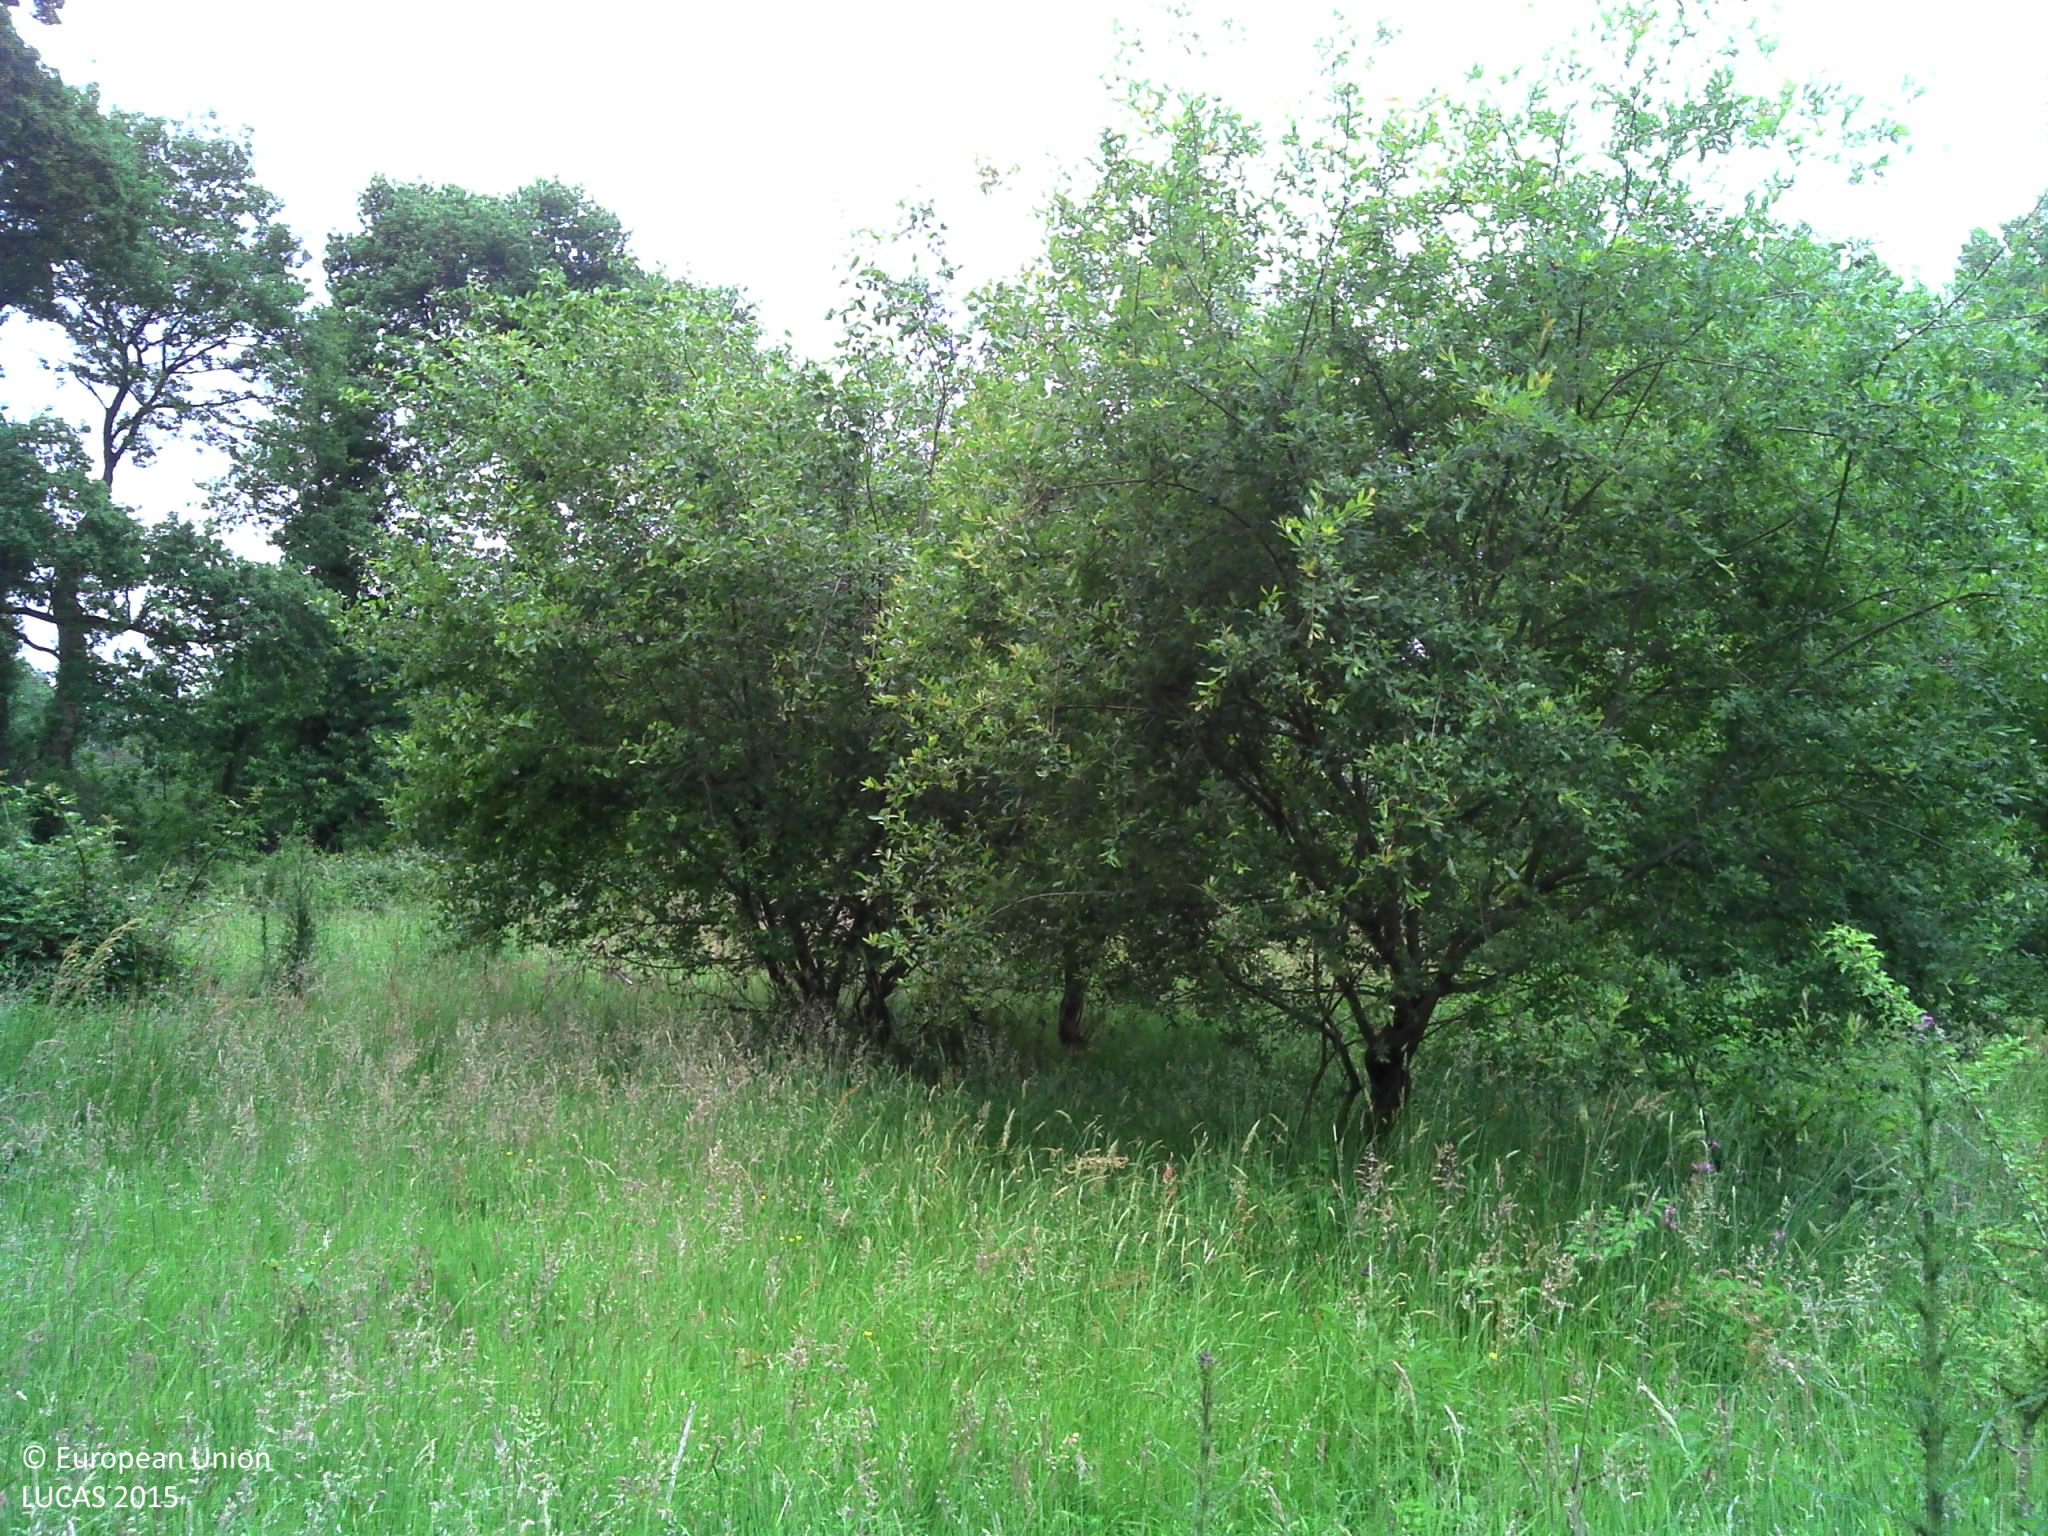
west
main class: Grassland
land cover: Spontaneously vegetated surfaces
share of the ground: > 75 %
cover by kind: herbaceous plants 100 %
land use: Abandoned areas
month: June
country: FR
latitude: 48.4804
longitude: -1.7800
